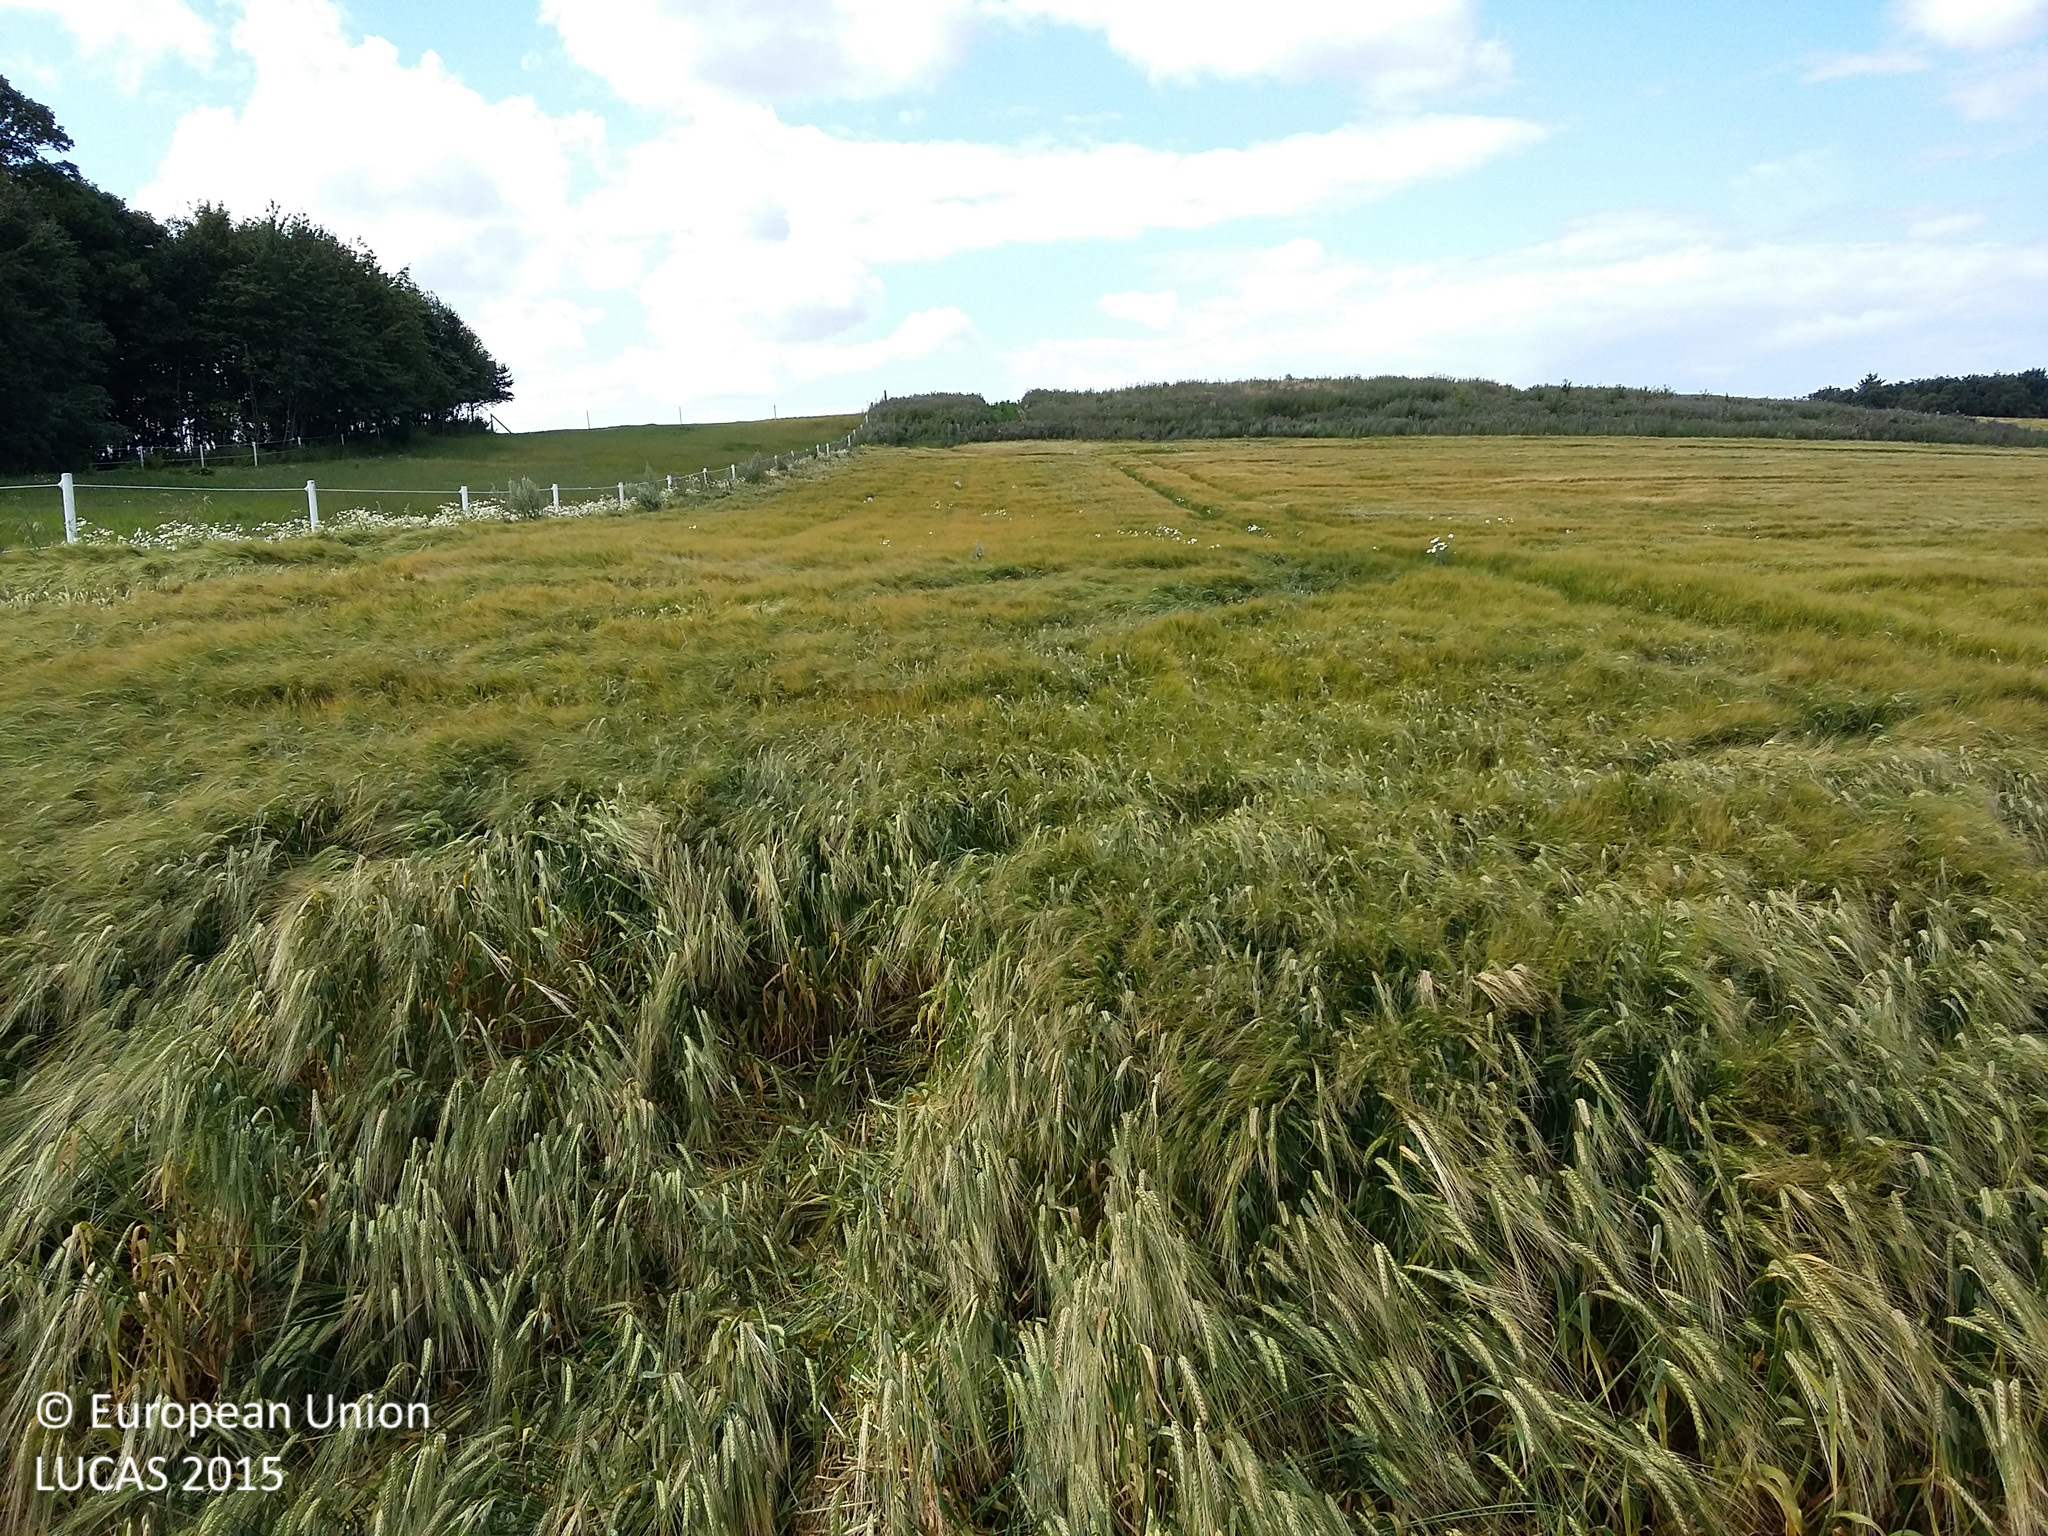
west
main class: Cropland
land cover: Barley
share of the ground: > 75 %
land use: Agriculture (excluding fallow land and kitchen gardens)
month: July
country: DK
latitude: 55.7634
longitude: 11.6718
